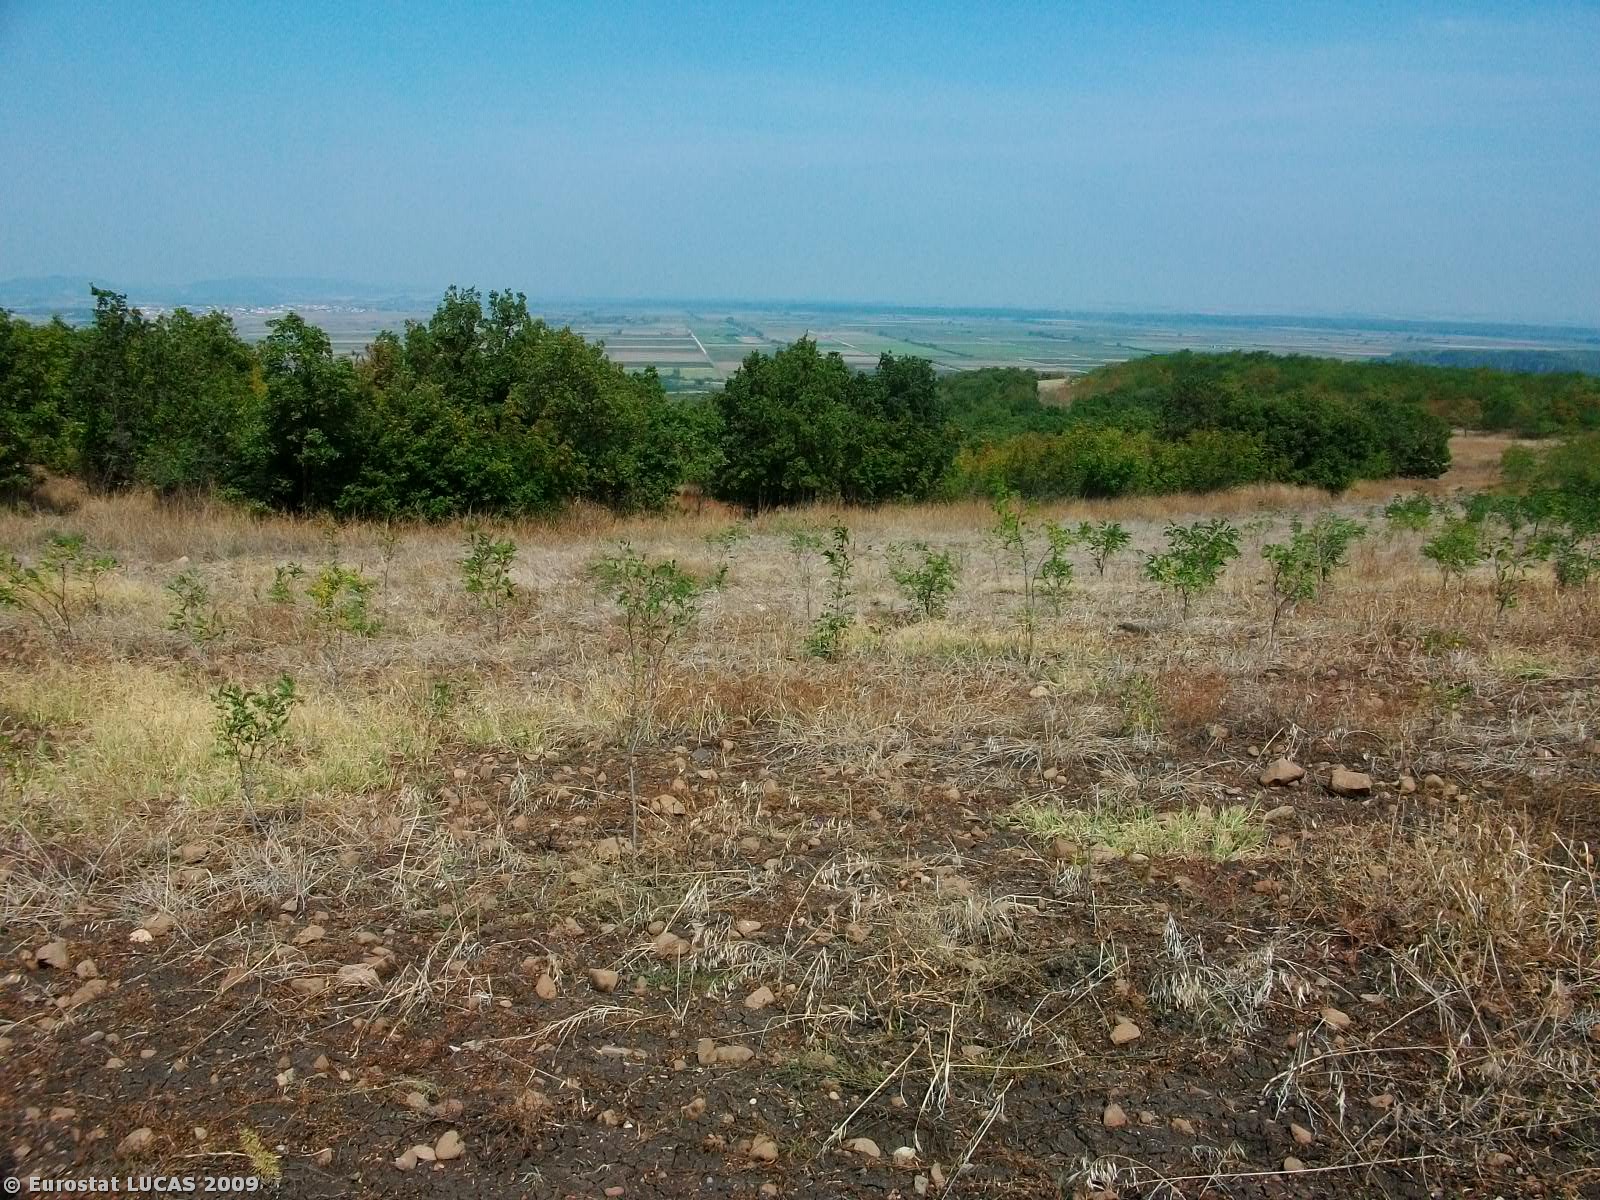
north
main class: Grassland
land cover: Grassland with sparse tree/shrub cover
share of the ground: 50 - 75 %
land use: Forestry
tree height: > 5 m
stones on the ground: 10 - 25 %
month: September
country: GR
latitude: 40.9718
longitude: 26.3116
